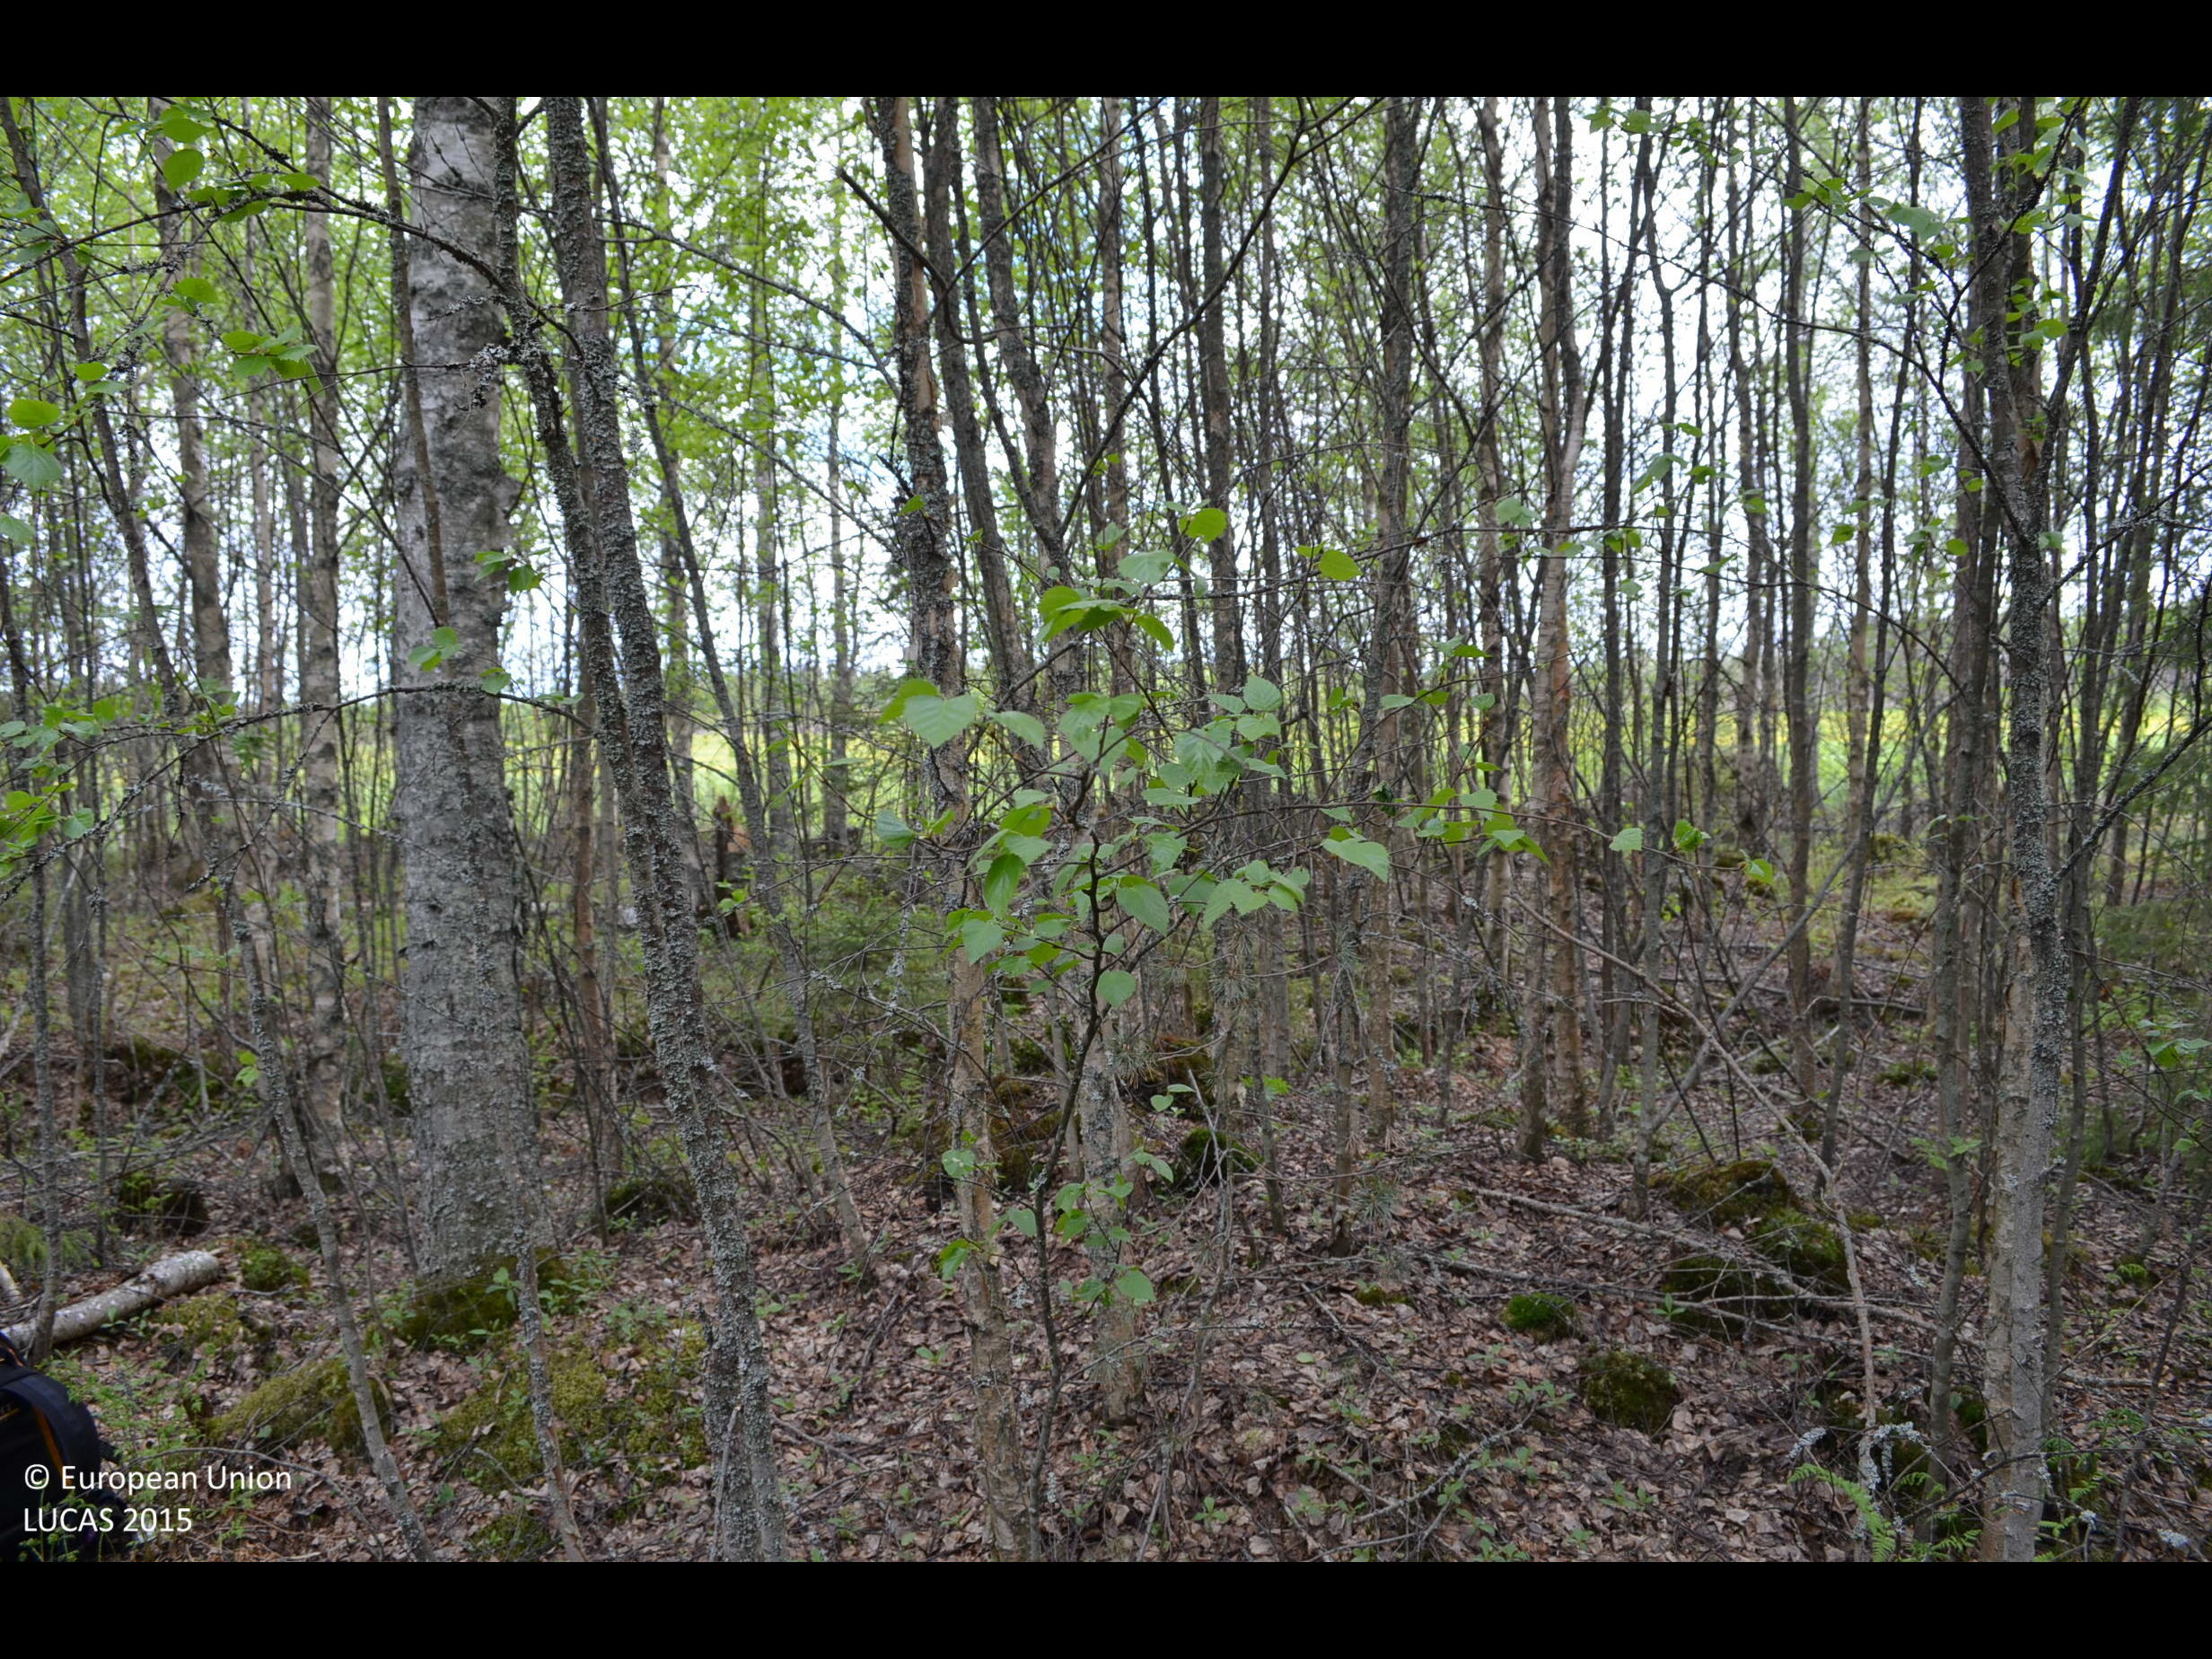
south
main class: Woodland
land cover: Broadleaved woodland
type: boreal forest
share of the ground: > 75 %
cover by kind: broadleaved forest trees 80 %, coniferous forest trees 10 %, lichens and mosses 10 %
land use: Forestry
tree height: > 5 m
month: June
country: FI
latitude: 61.6751
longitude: 23.0499
